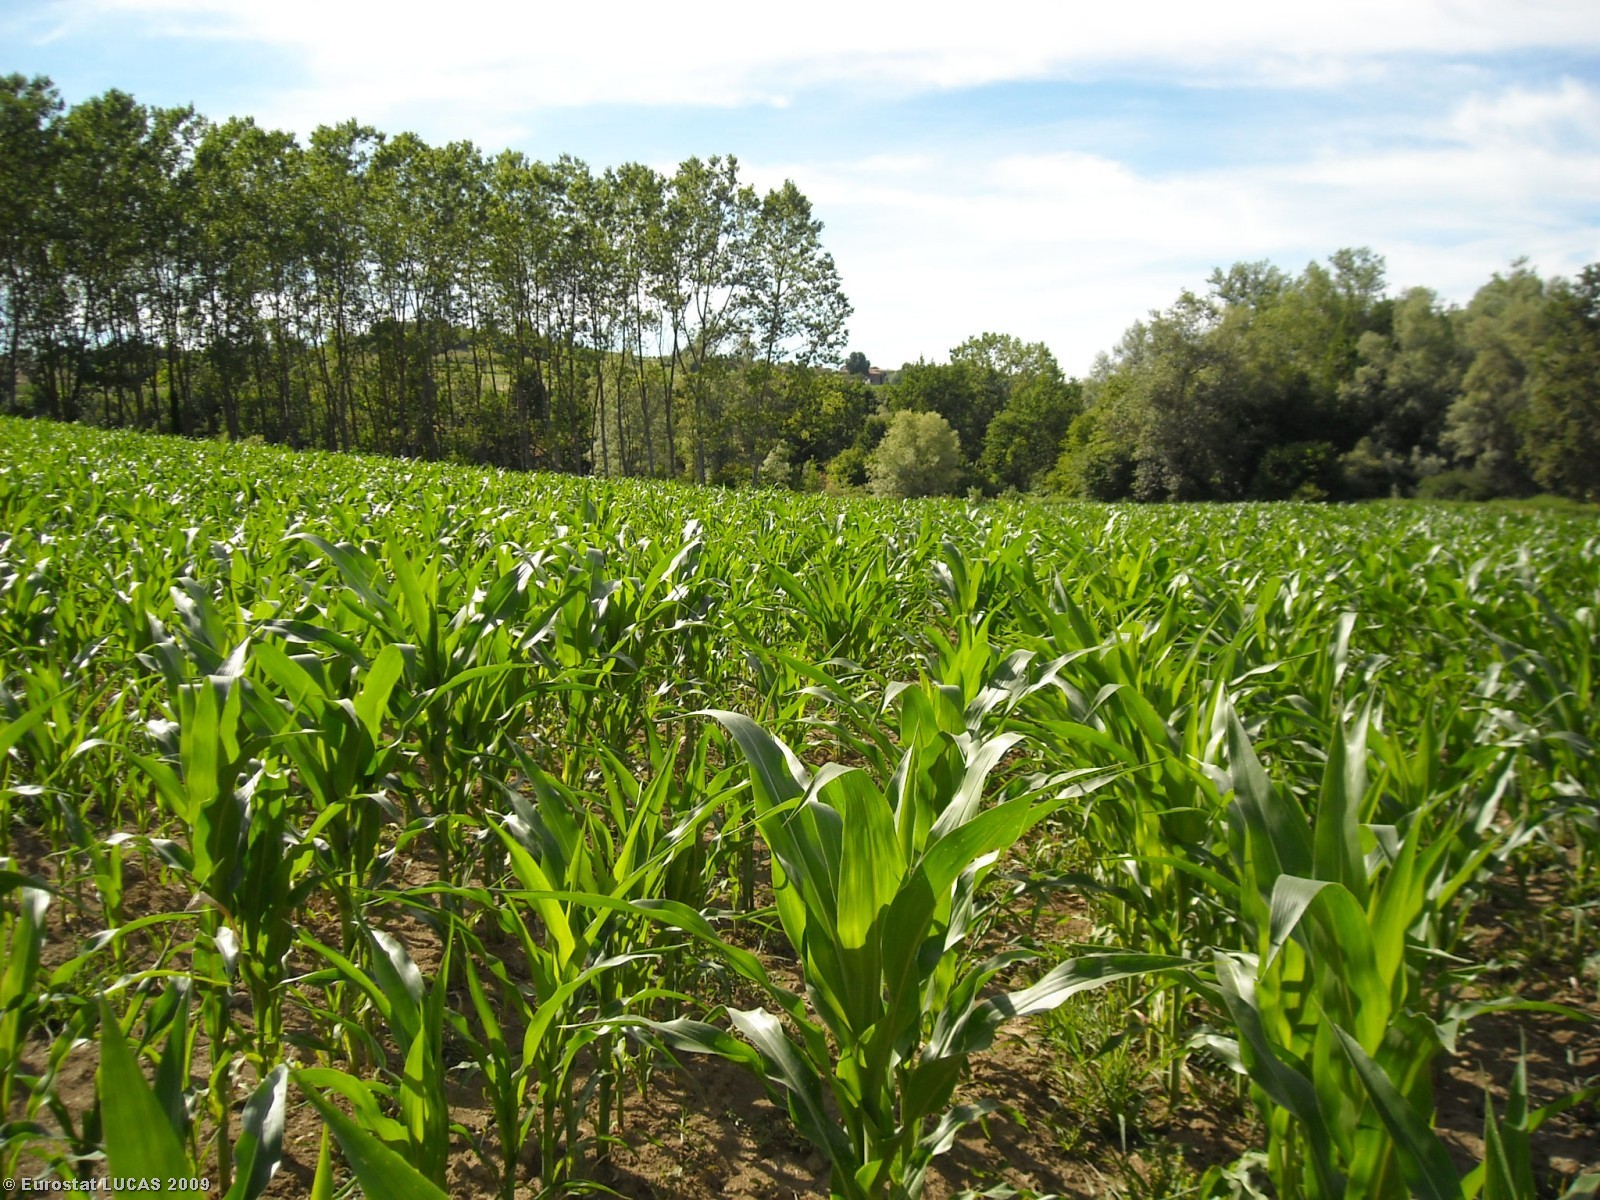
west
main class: Cropland
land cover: Maize
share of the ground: > 75 %
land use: Agriculture (excluding fallow land and kitchen gardens)
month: June
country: IT
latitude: 45.0544
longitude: 8.0861
